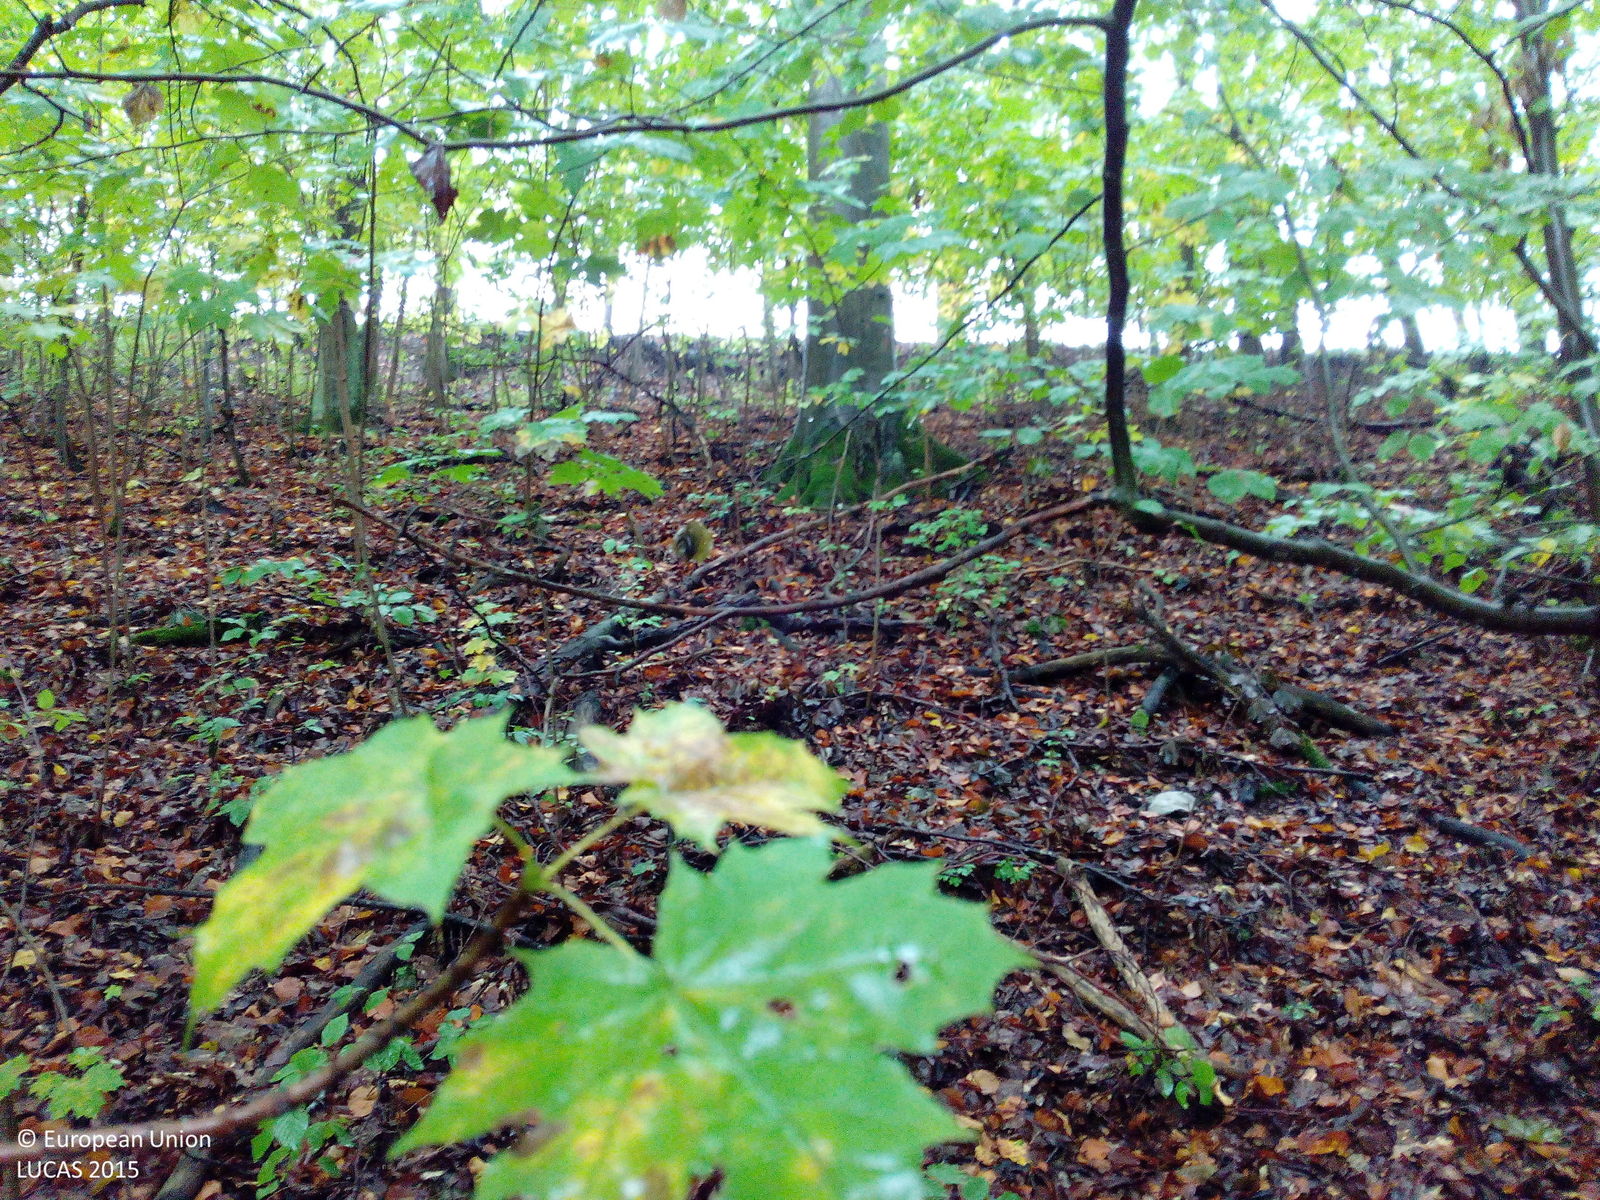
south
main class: Woodland
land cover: Broadleaved woodland
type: beech forest
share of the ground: 50 - 75 %
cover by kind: broadleaved forest trees 70 %, unconsolidated bare surface 15 %, shrubs 10 %, herbaceous plants 5 %
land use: Forestry
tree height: > 5 m
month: October
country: DE
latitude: 50.0943
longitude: 9.9022
